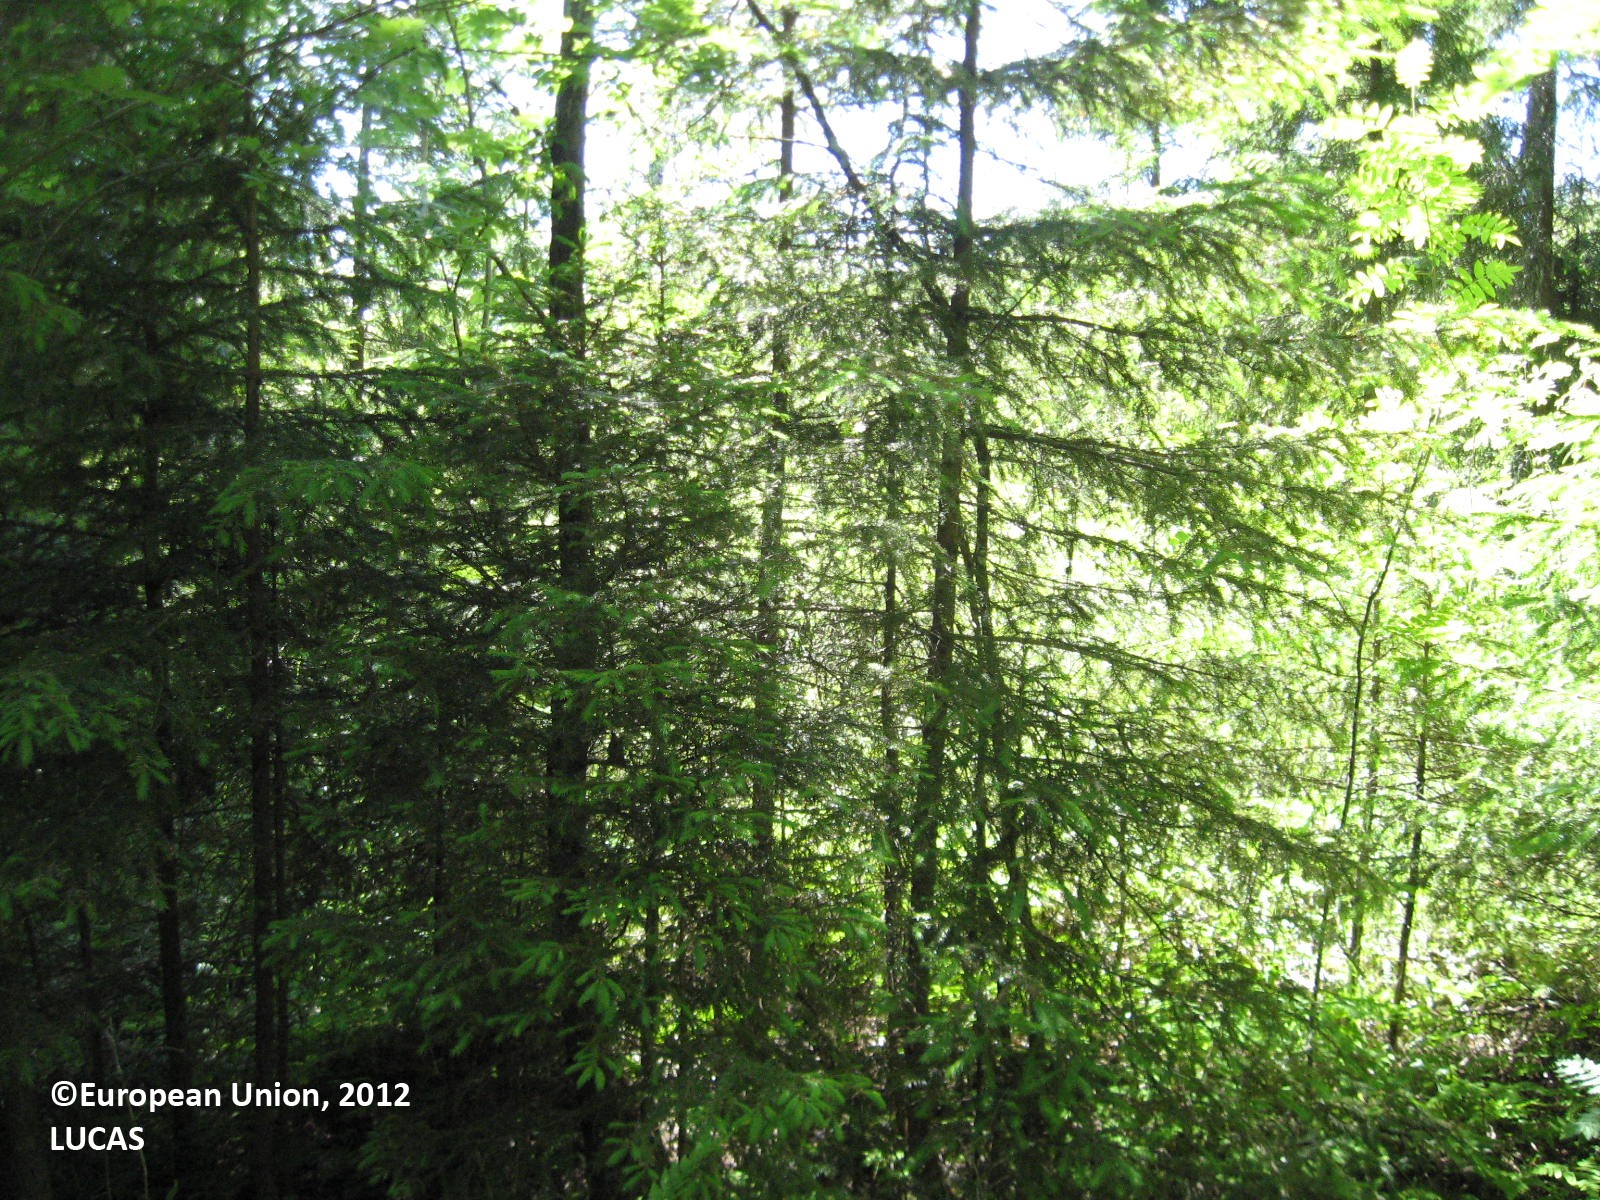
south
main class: Woodland
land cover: Spruce dominated mixed woodland
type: boreal forest
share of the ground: > 75 %
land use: Forestry
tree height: > 5 m
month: June
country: FI
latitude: 62.8729
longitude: 21.8592
